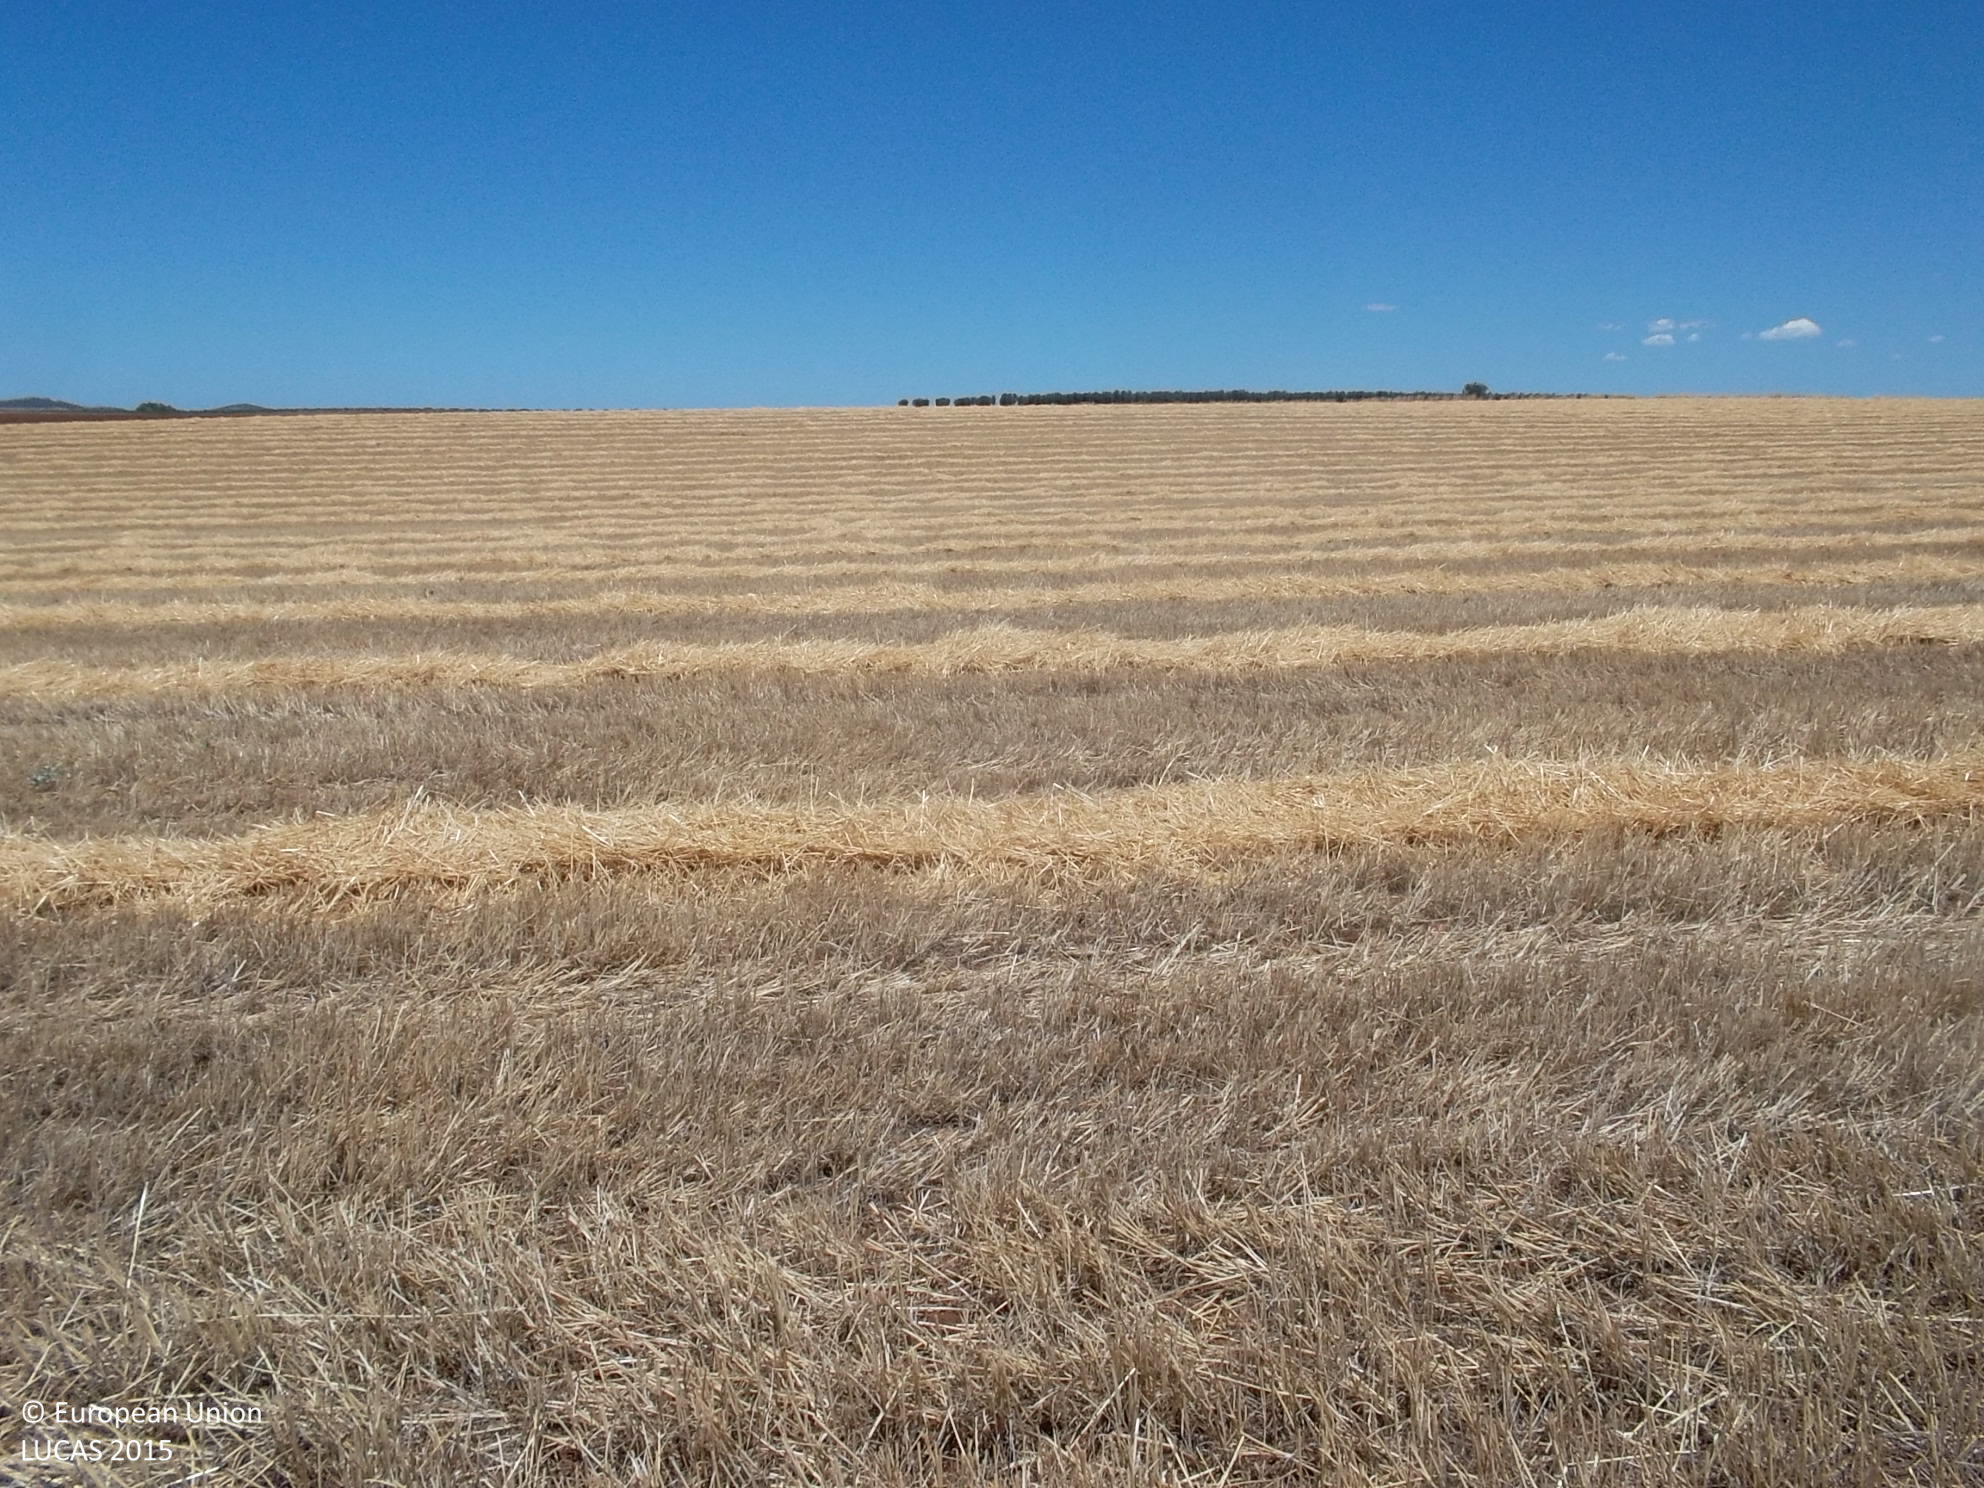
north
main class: Cropland
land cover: Common wheat
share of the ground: < 10 %
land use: Agriculture (excluding fallow land and kitchen gardens)
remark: Harvested field
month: July
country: ES
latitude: 38.3530
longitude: -5.7950
